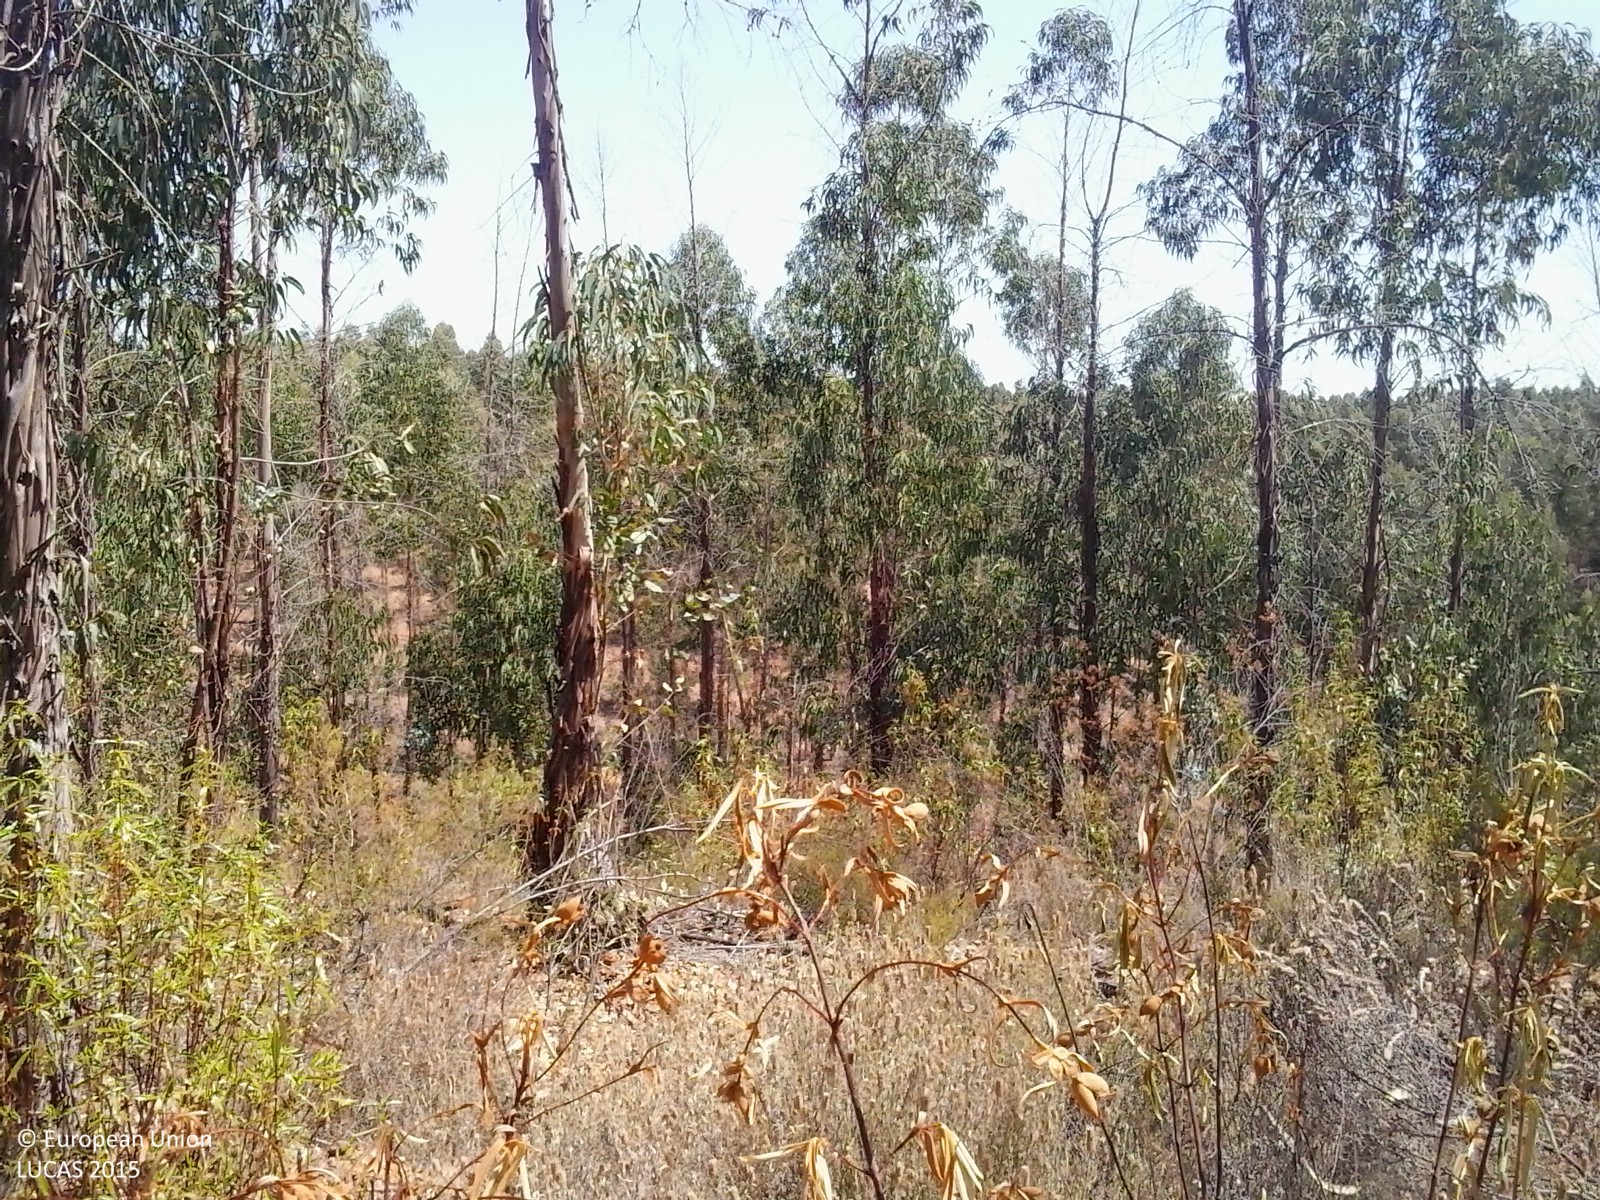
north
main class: Woodland
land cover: Broadleaved woodland
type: exotic forest
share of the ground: 25 - 50 %
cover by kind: broadleaved forest trees 45 %, shrubs 25 %, herbaceous plants 25 %, unconsolidated bare surface 5 %
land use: Forestry
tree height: > 5 m
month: July
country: ES
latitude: 37.5219
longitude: -6.4520
